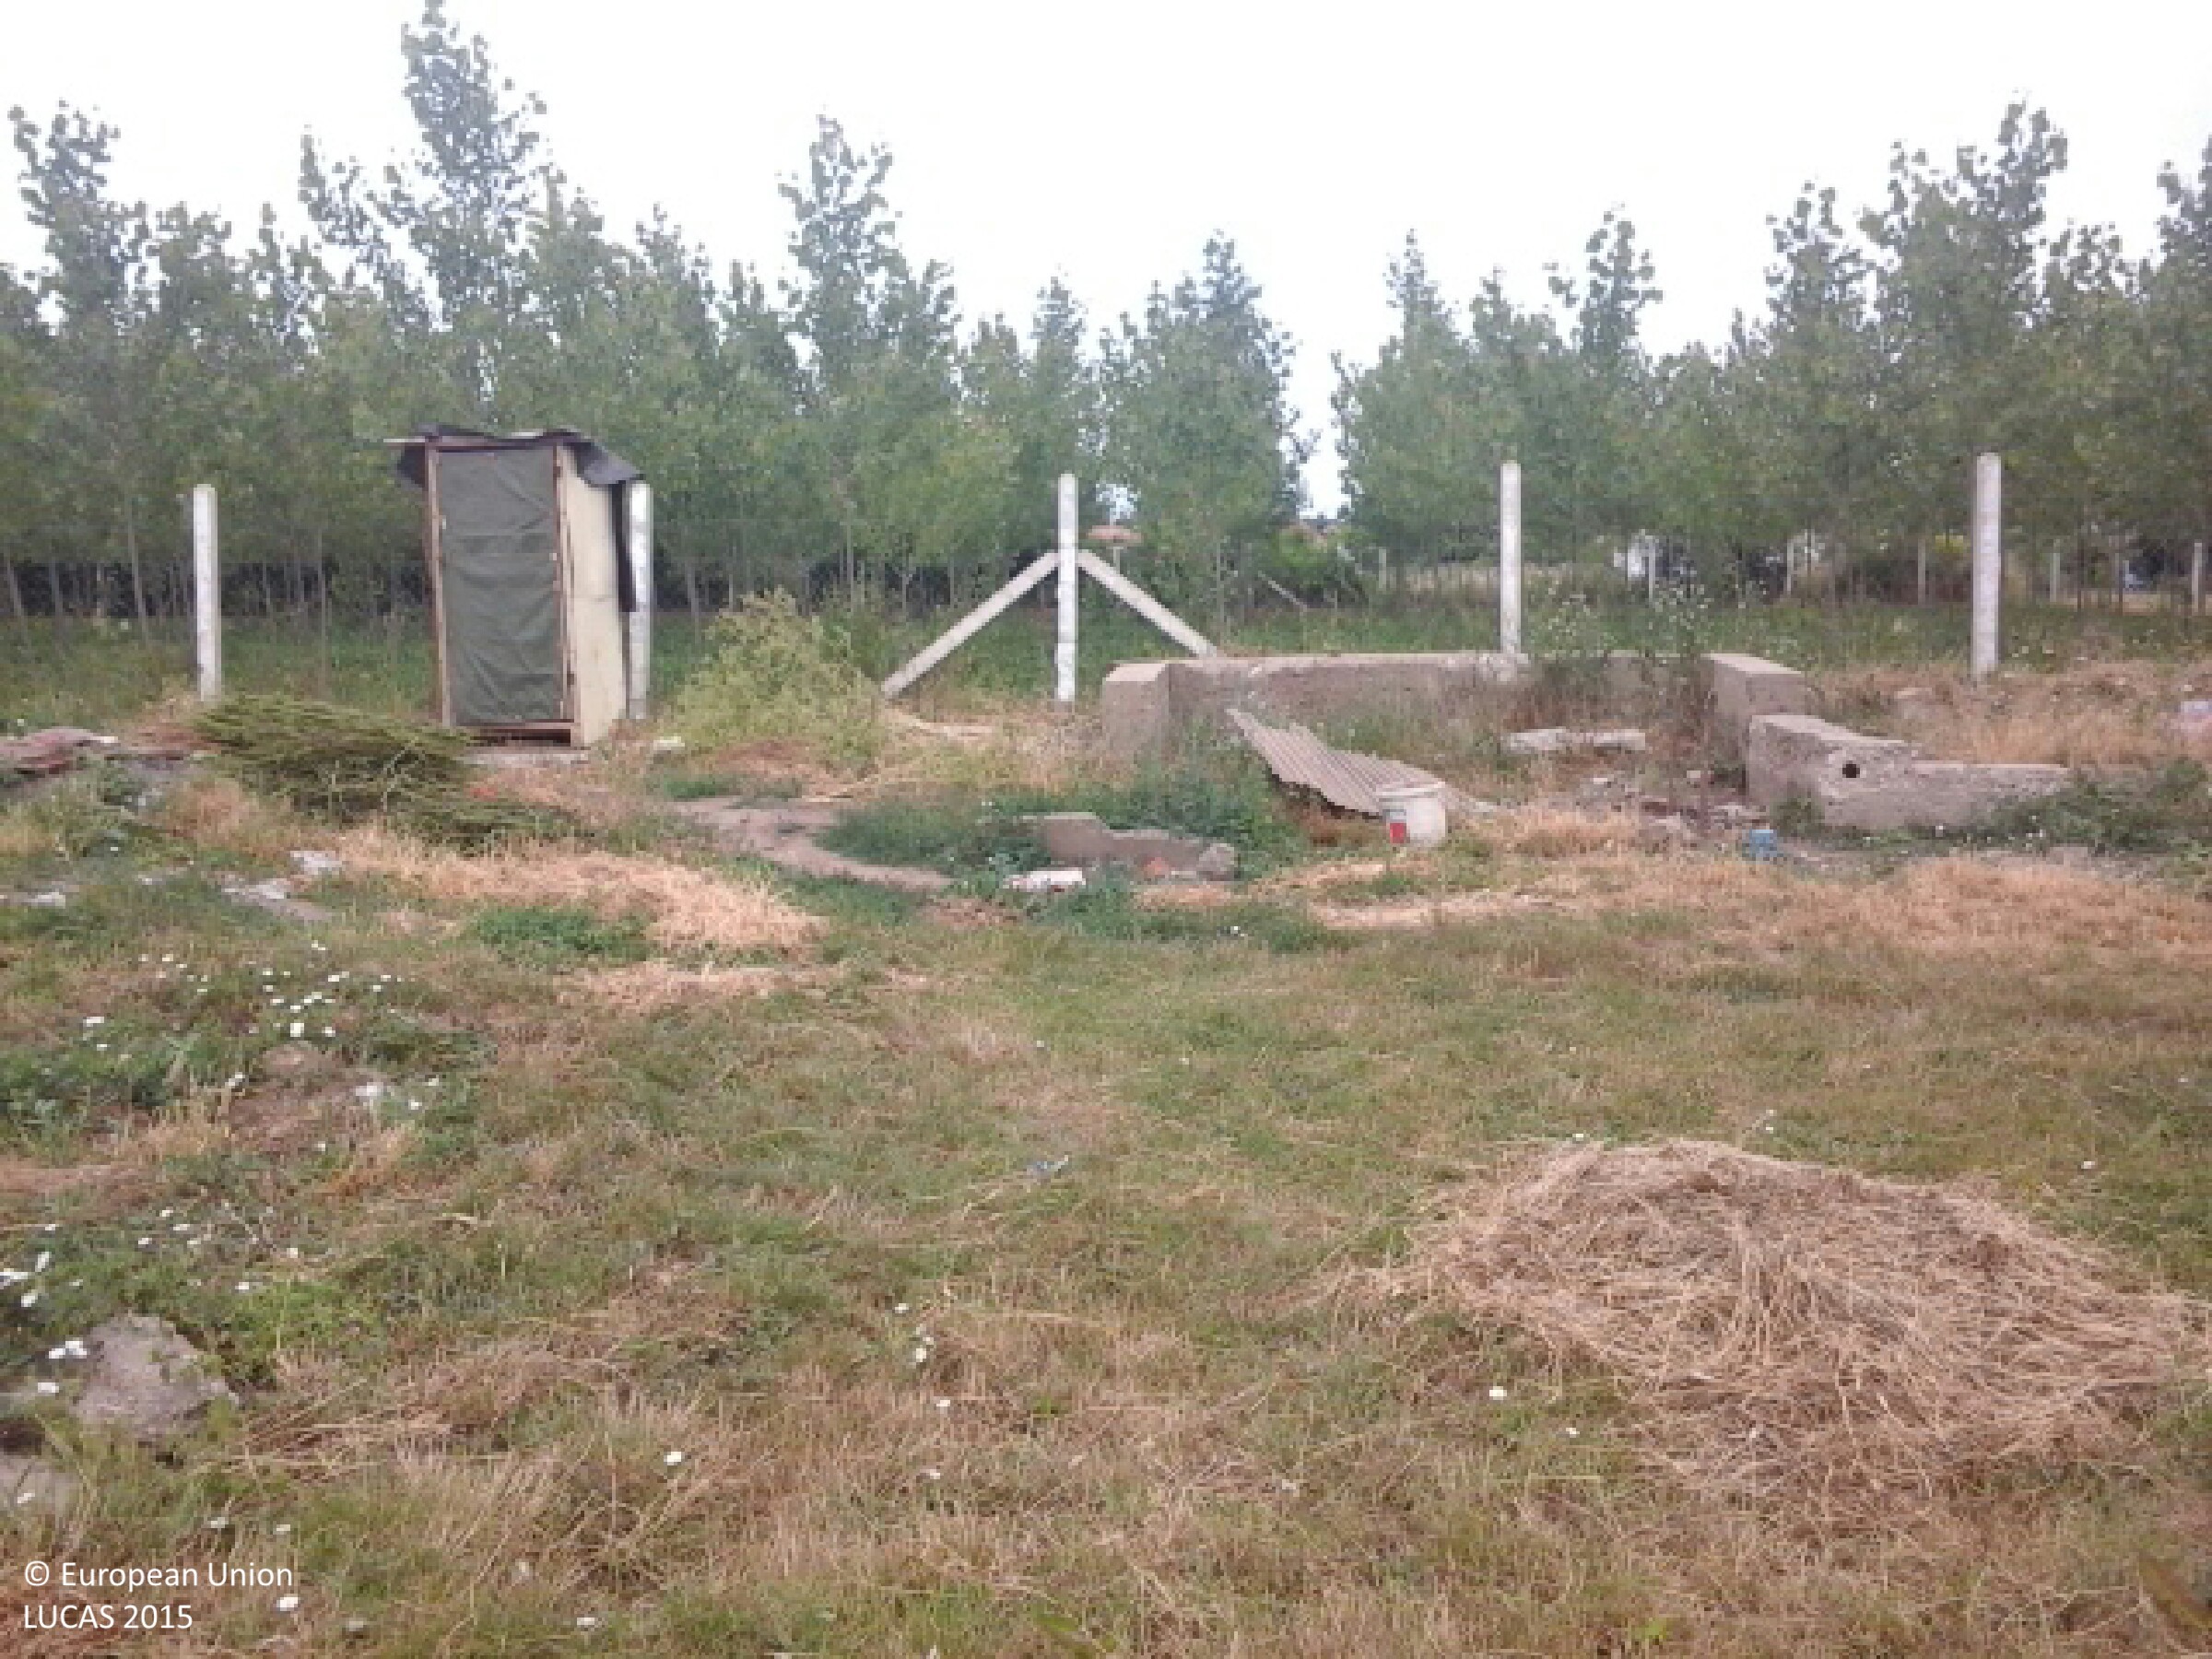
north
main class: Grassland
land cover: Grassland without tree/shrub cover
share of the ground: > 75 %
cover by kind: herbaceous plants 100 %
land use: Residential
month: June
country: HU
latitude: 48.0240
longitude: 21.4555
